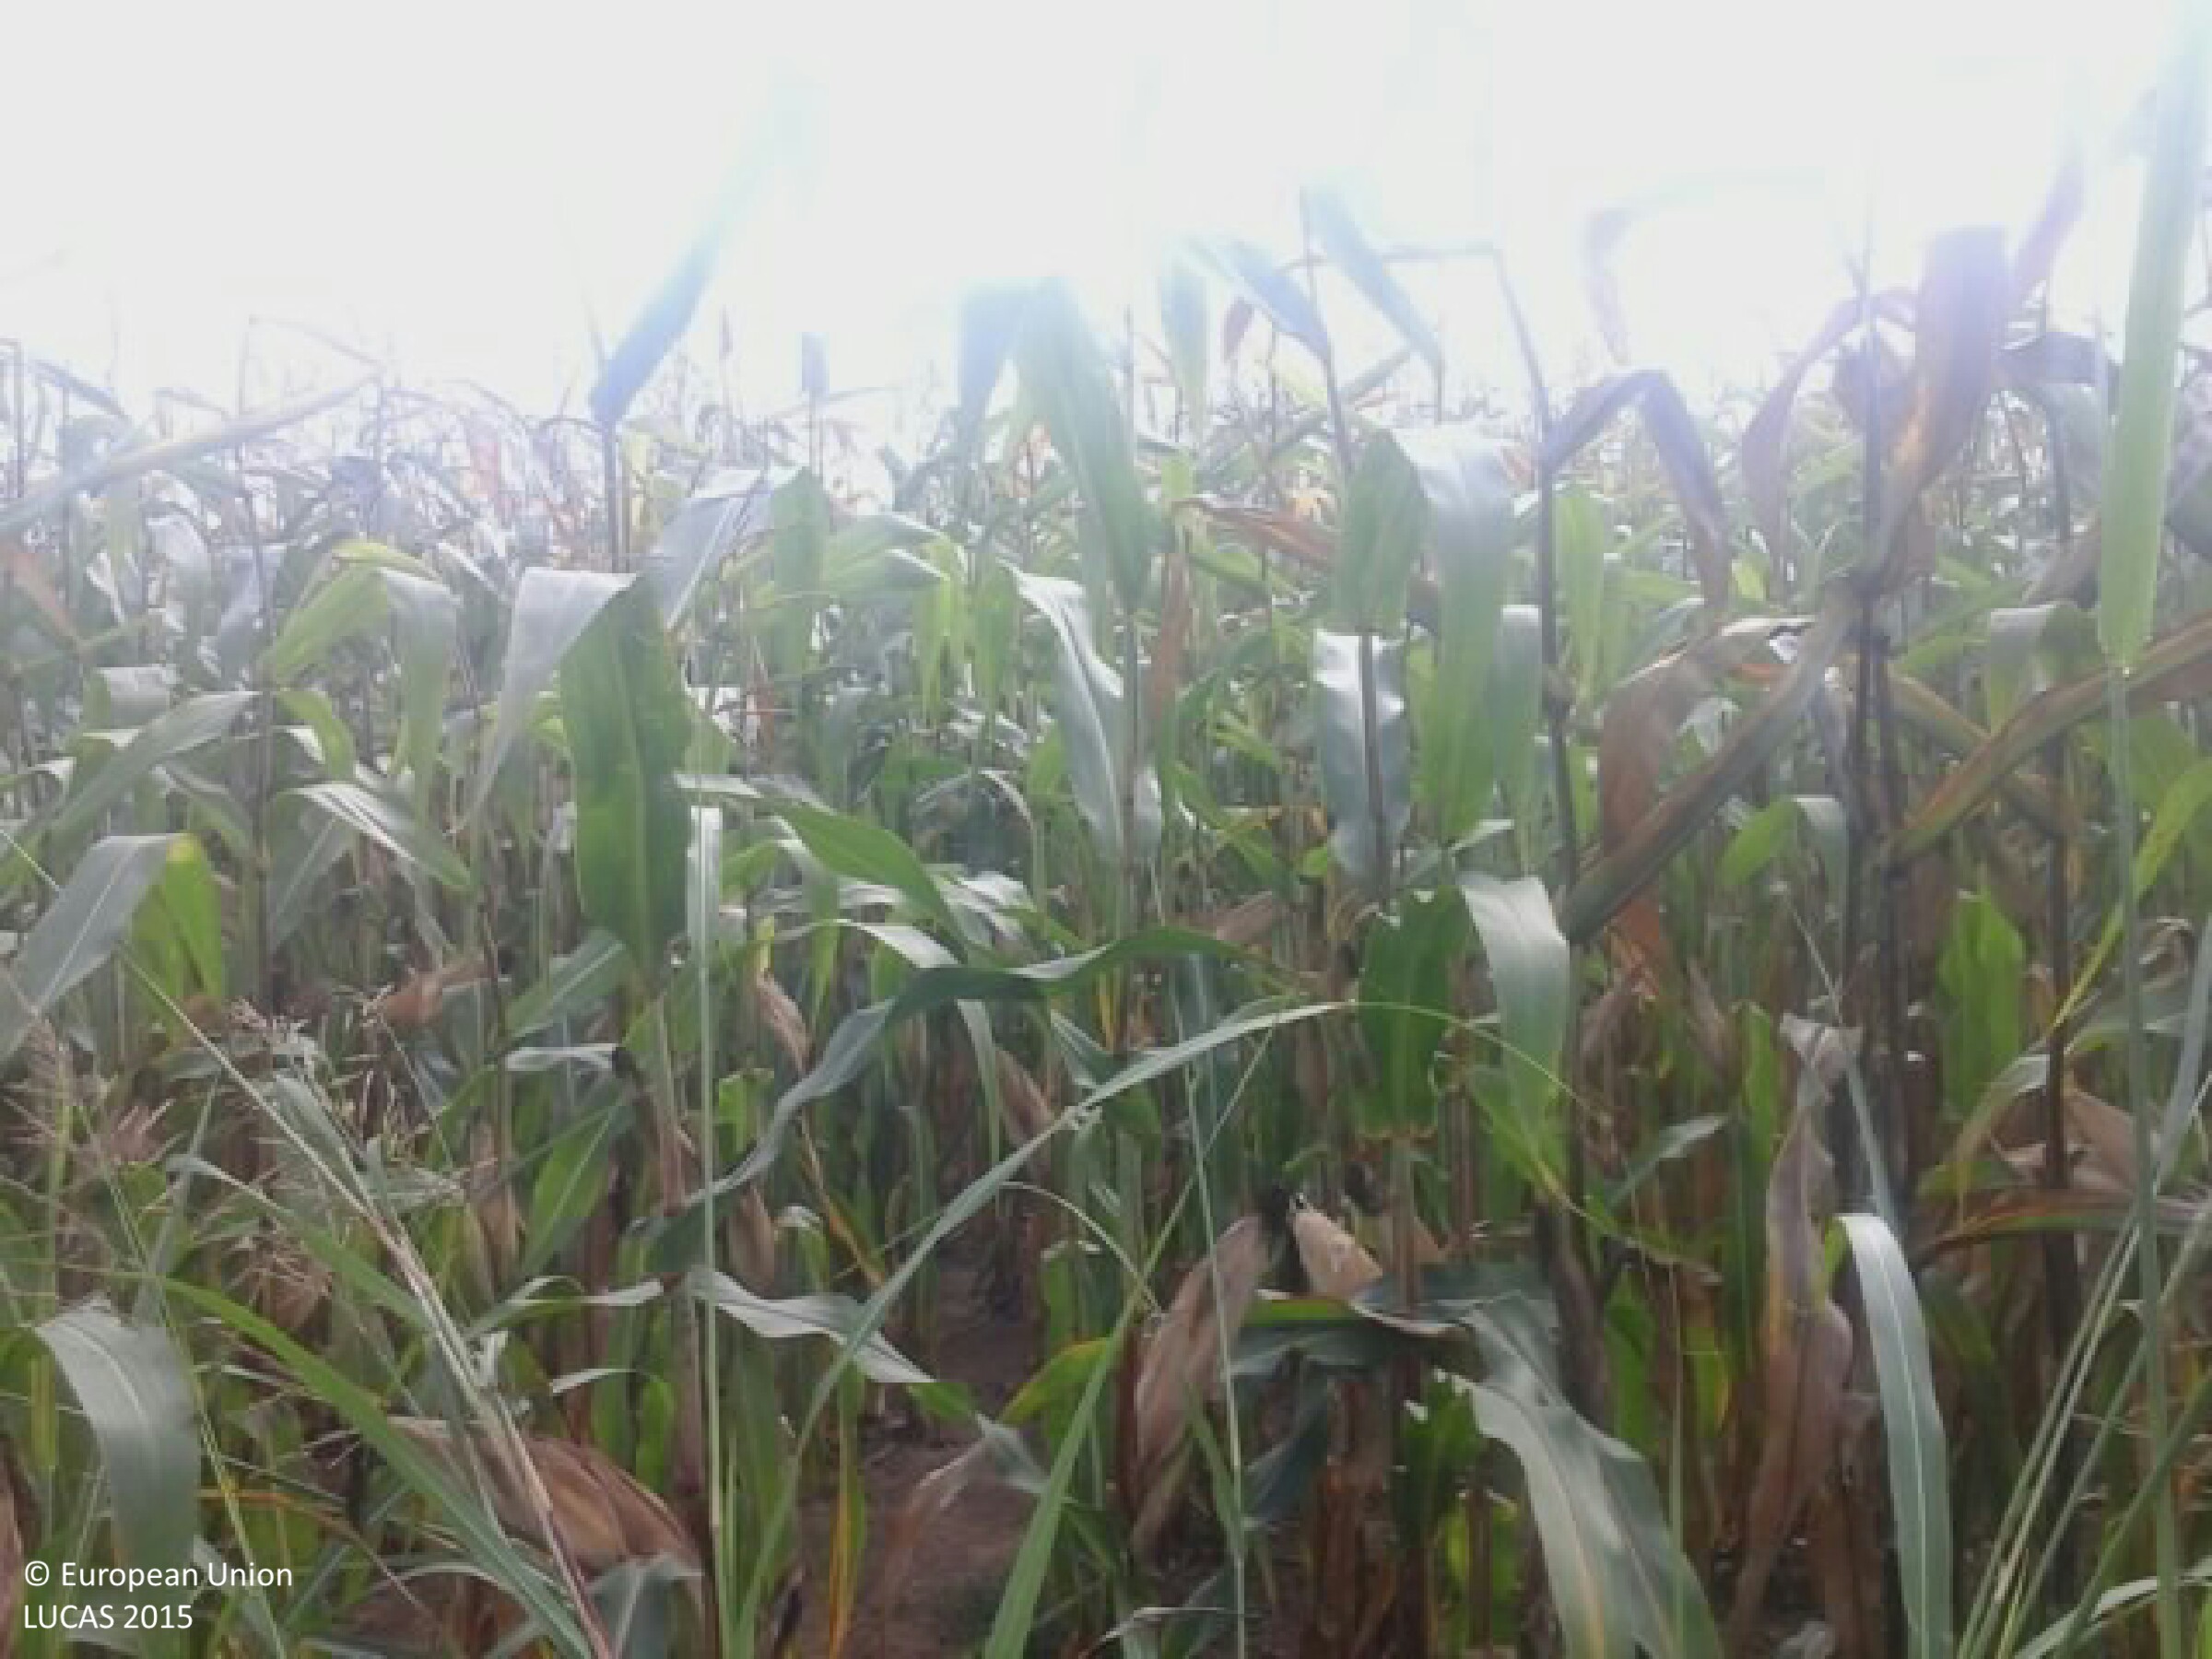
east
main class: Cropland
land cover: Maize
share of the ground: > 75 %
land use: Agriculture (excluding fallow land and kitchen gardens)
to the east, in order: Maize; Common wheat
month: August
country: HU
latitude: 46.4354
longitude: 17.6974
